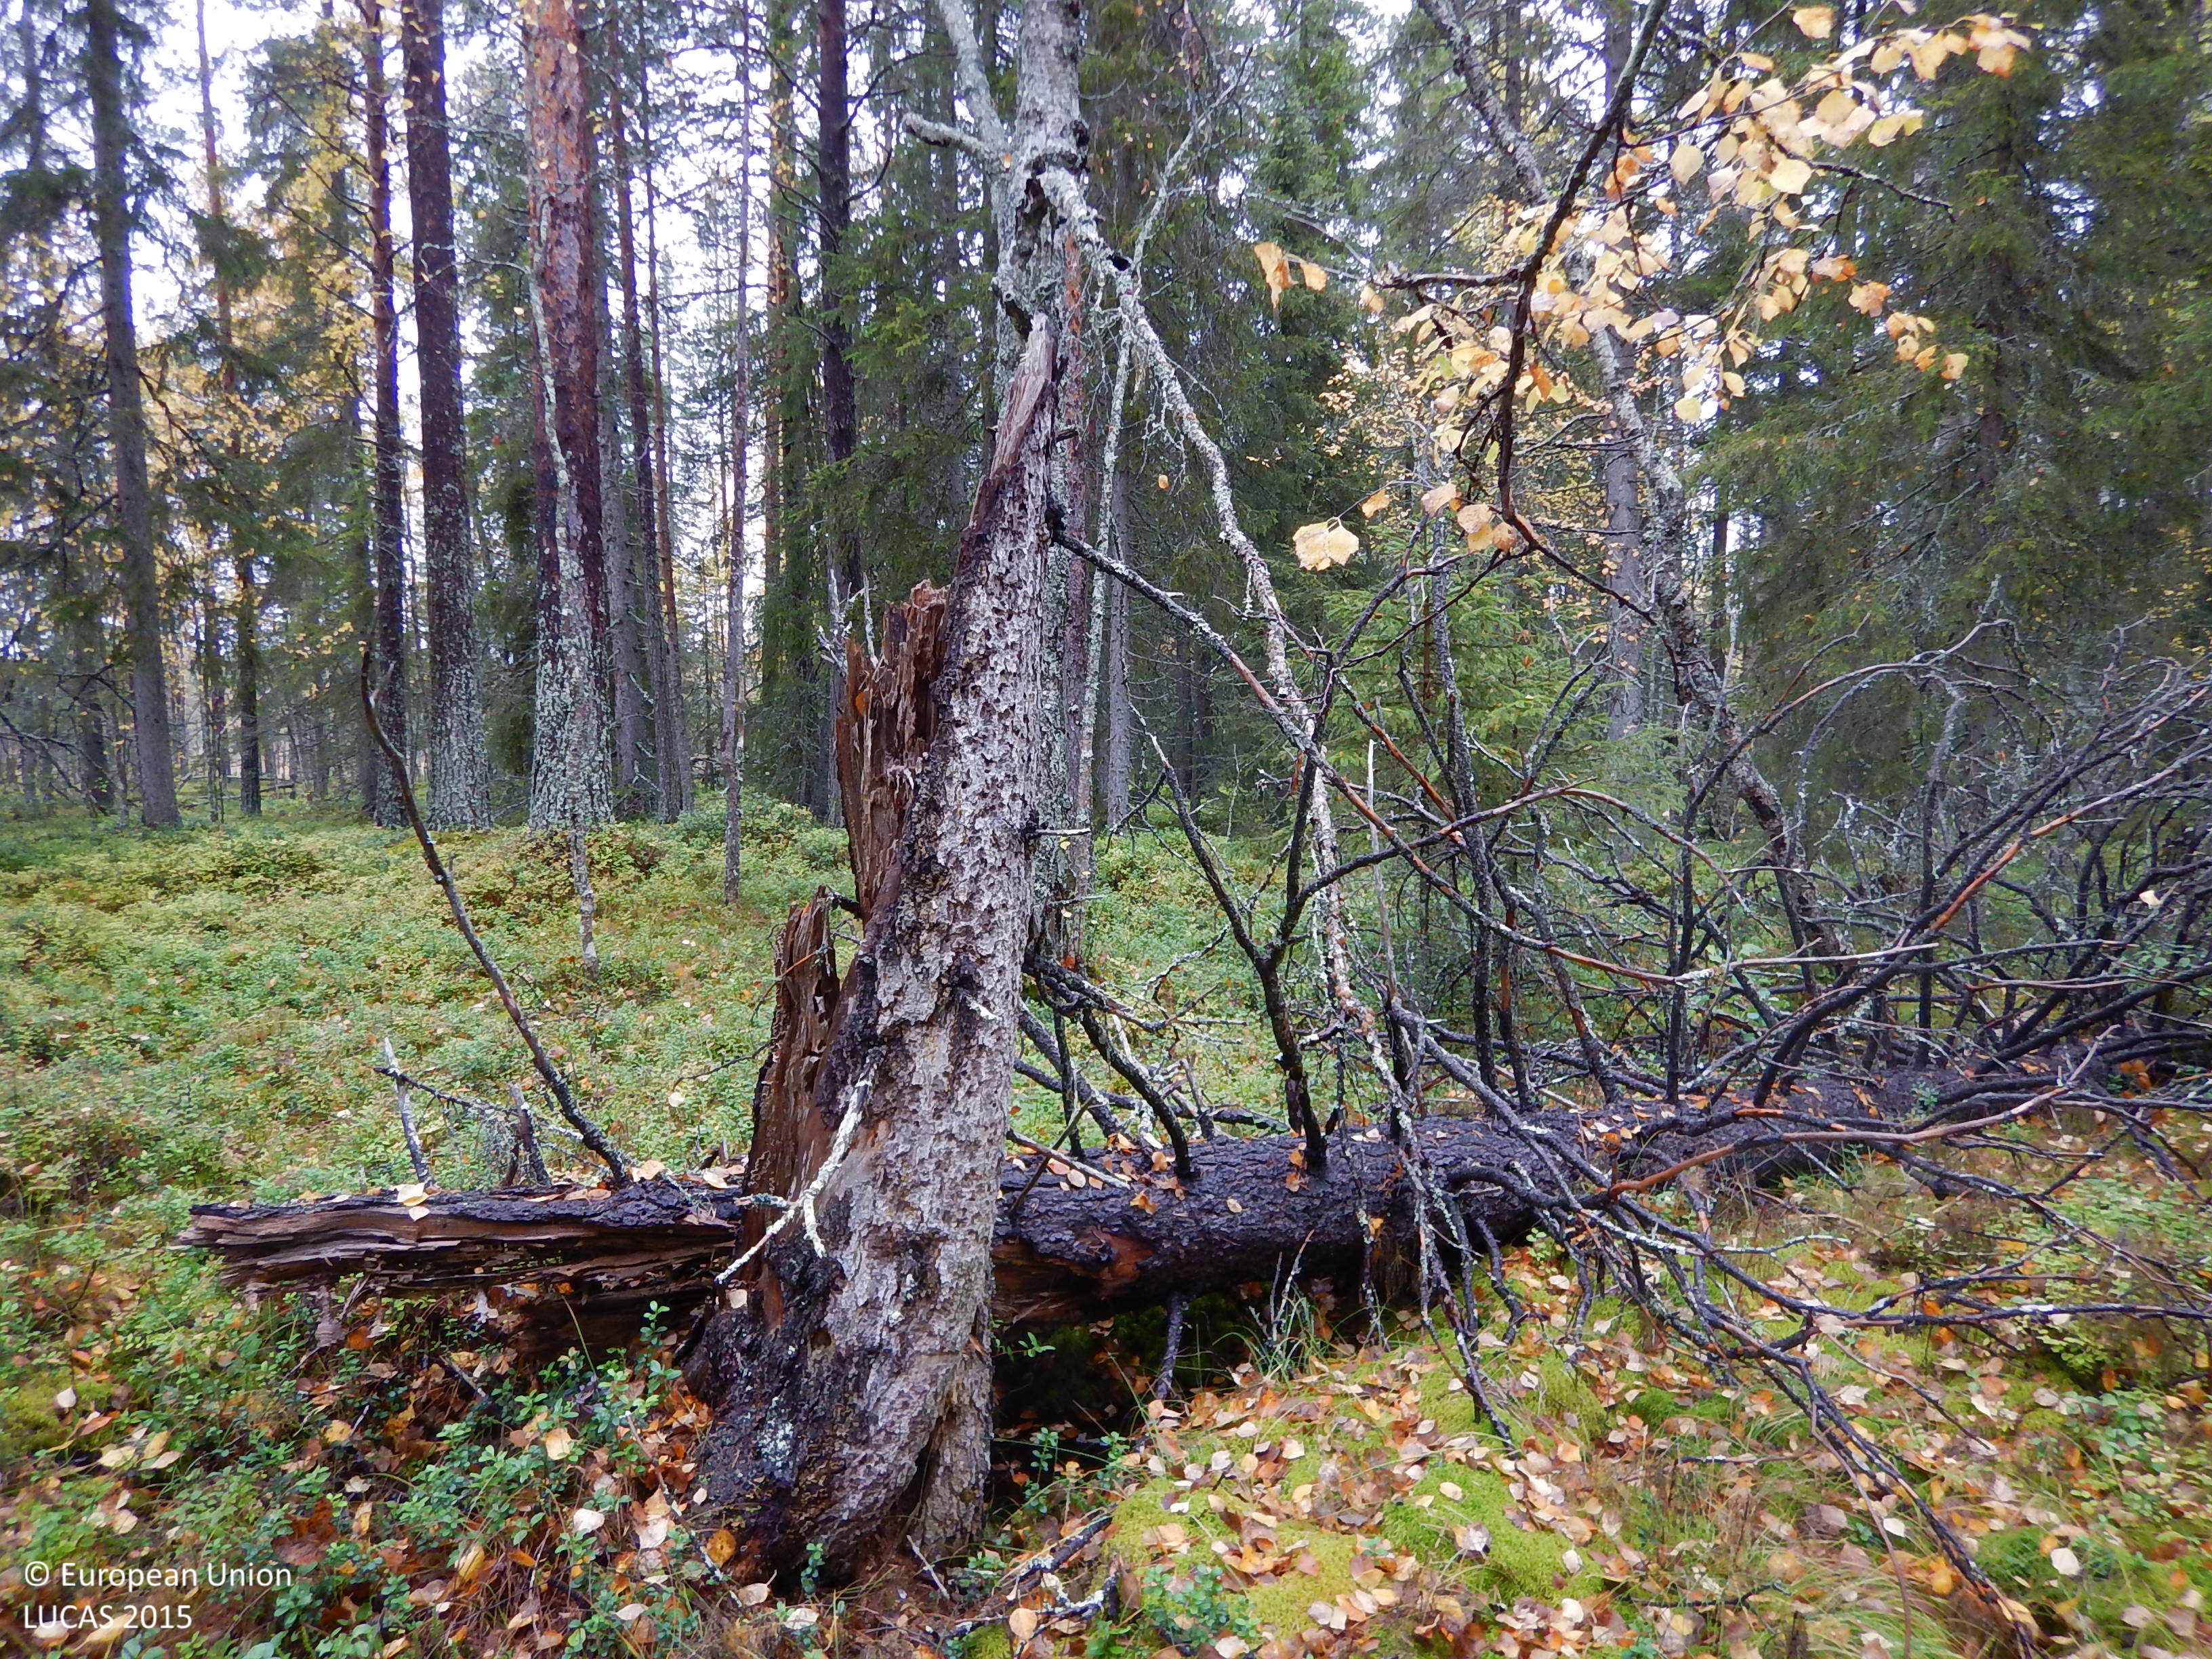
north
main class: Woodland
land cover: Other mixed woodland
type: mire and swamp forests
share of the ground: 50 - 75 %
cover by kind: coniferous forest trees 30 %, broadleaved forest trees 30 %, lichens and mosses 20 %, shrubs 10 %, herbaceous plants 10 %
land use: Amenities, museums, leisure
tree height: > 5 m
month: September
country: SE
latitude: 65.0881
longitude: 19.9470
